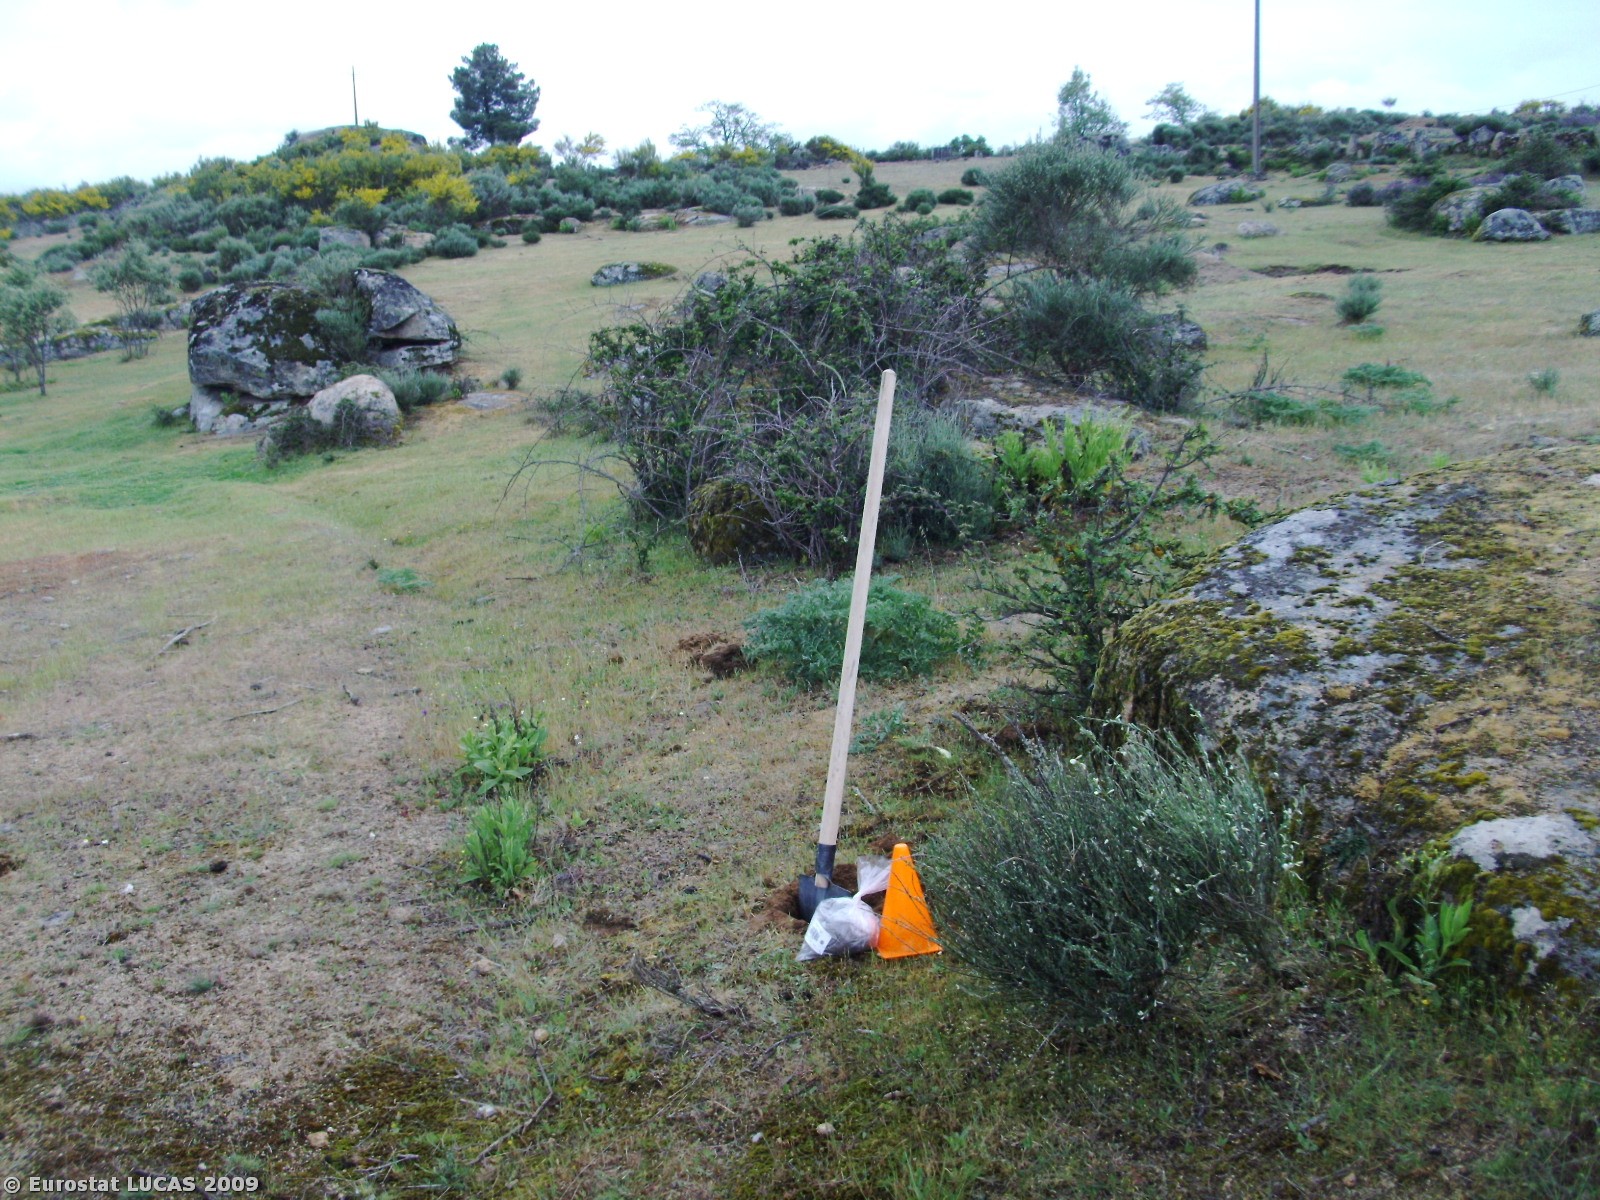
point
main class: Grassland
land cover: Spontaneously vegetated surfaces
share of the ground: > 75 %
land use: Fallow land
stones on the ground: 25 - 50 %
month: May
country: PT
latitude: 40.6881
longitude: -7.1083
